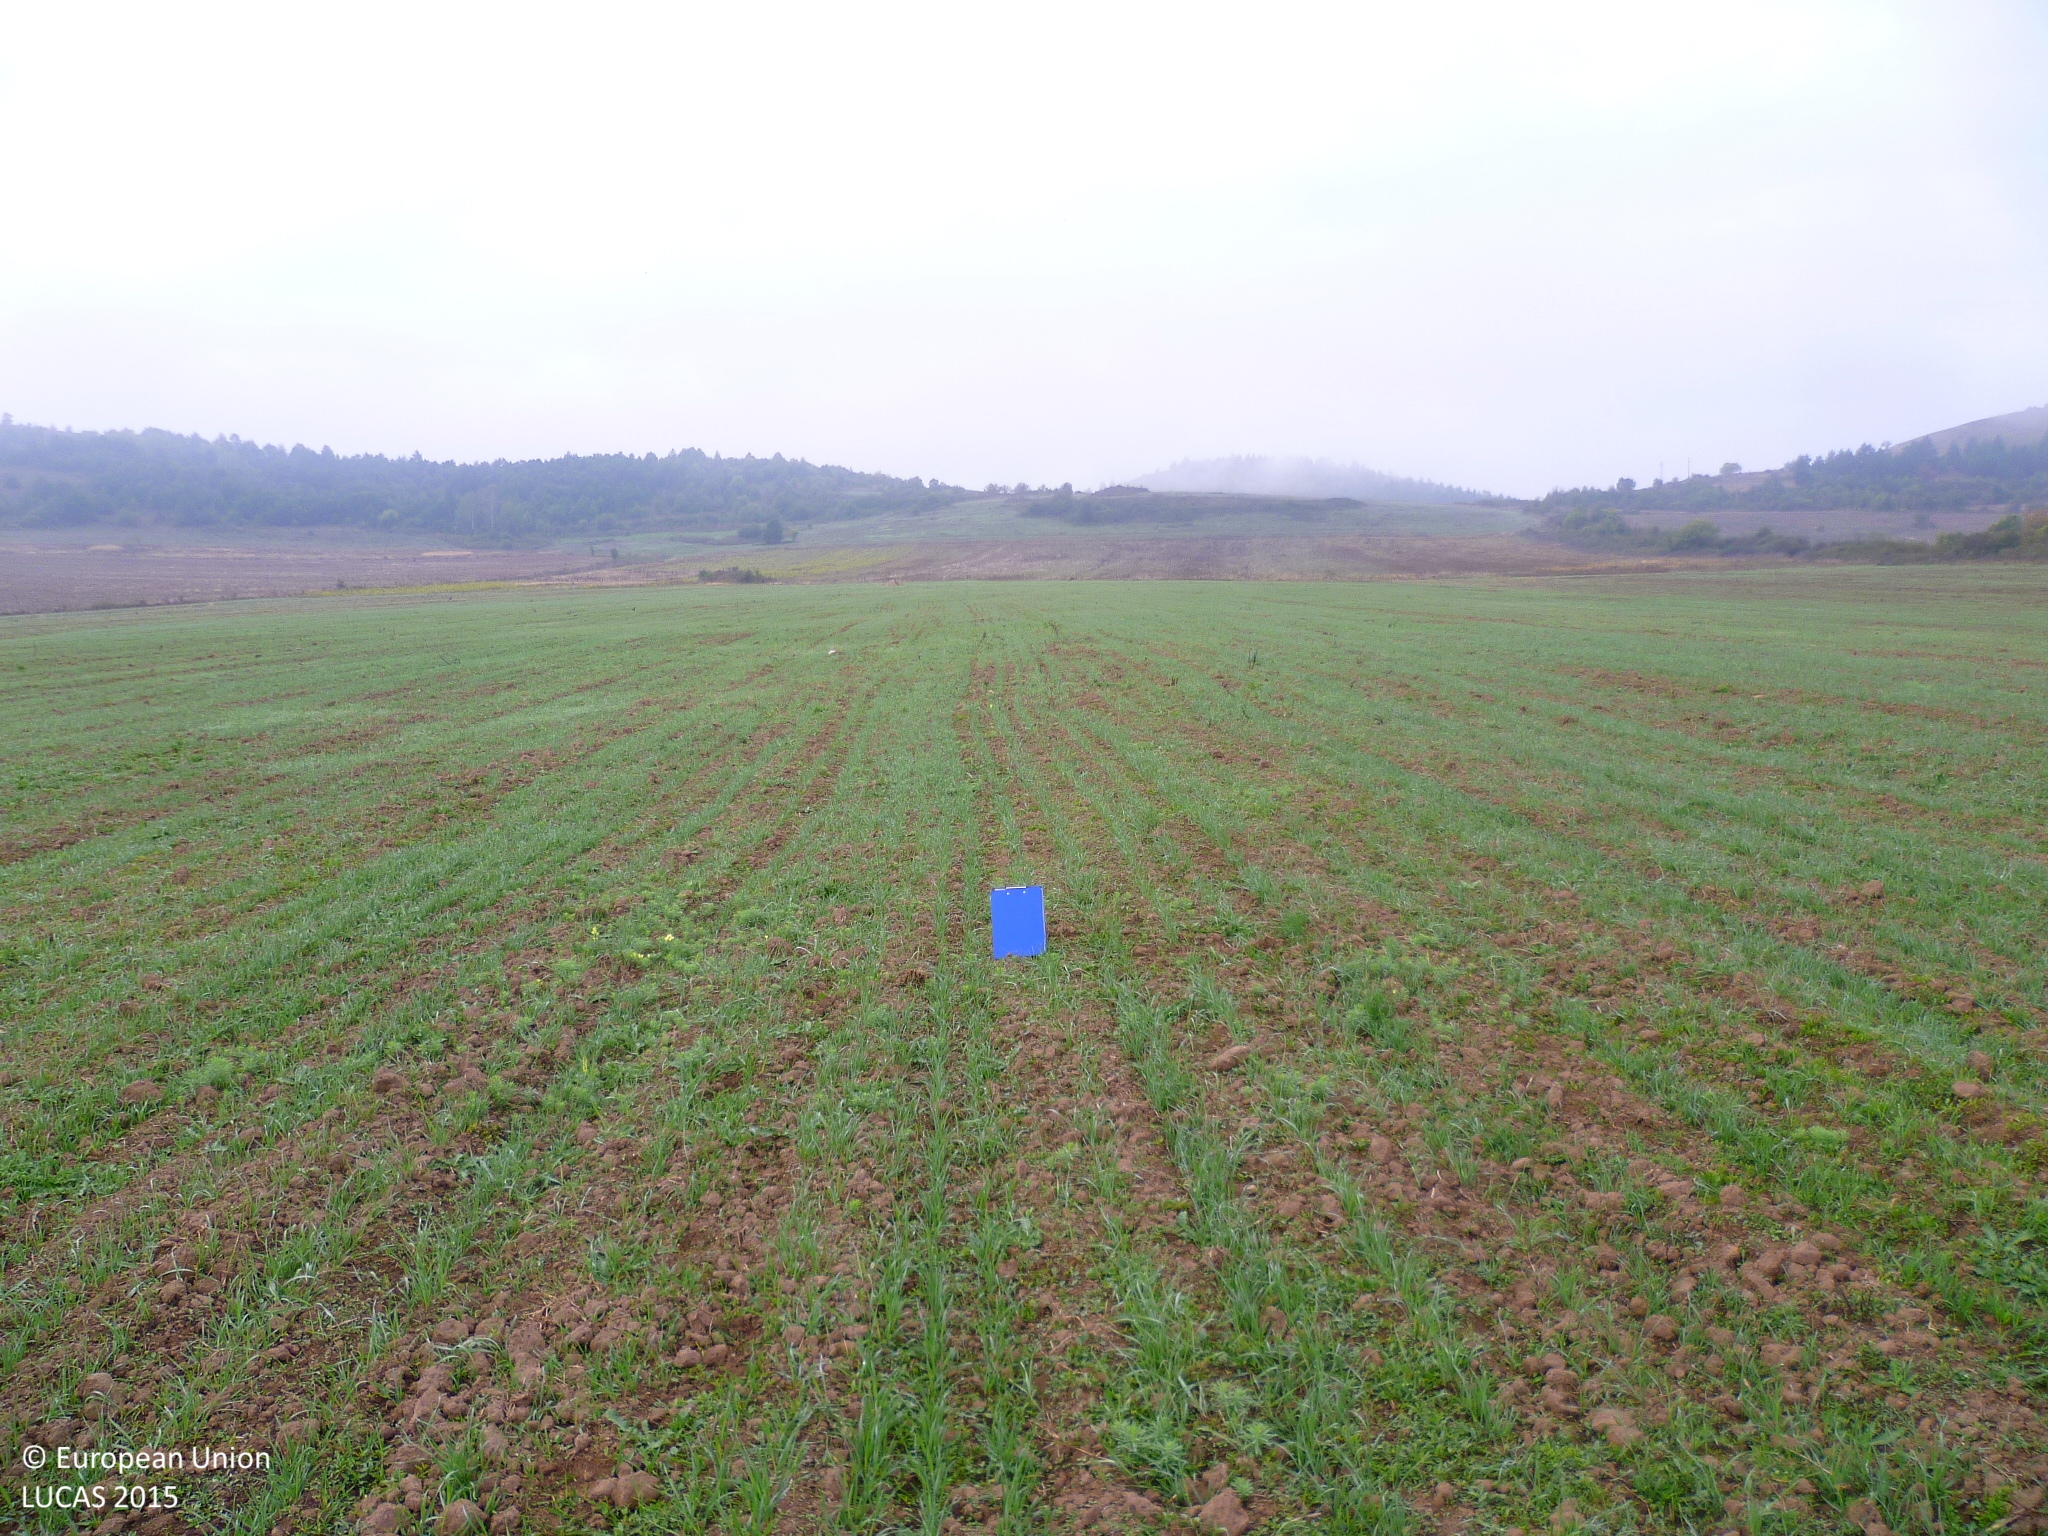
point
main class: Cropland
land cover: Common wheat
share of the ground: 25 - 50 %
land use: Agriculture (excluding fallow land and kitchen gardens)
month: October
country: BG
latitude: 42.8087
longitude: 22.6339
